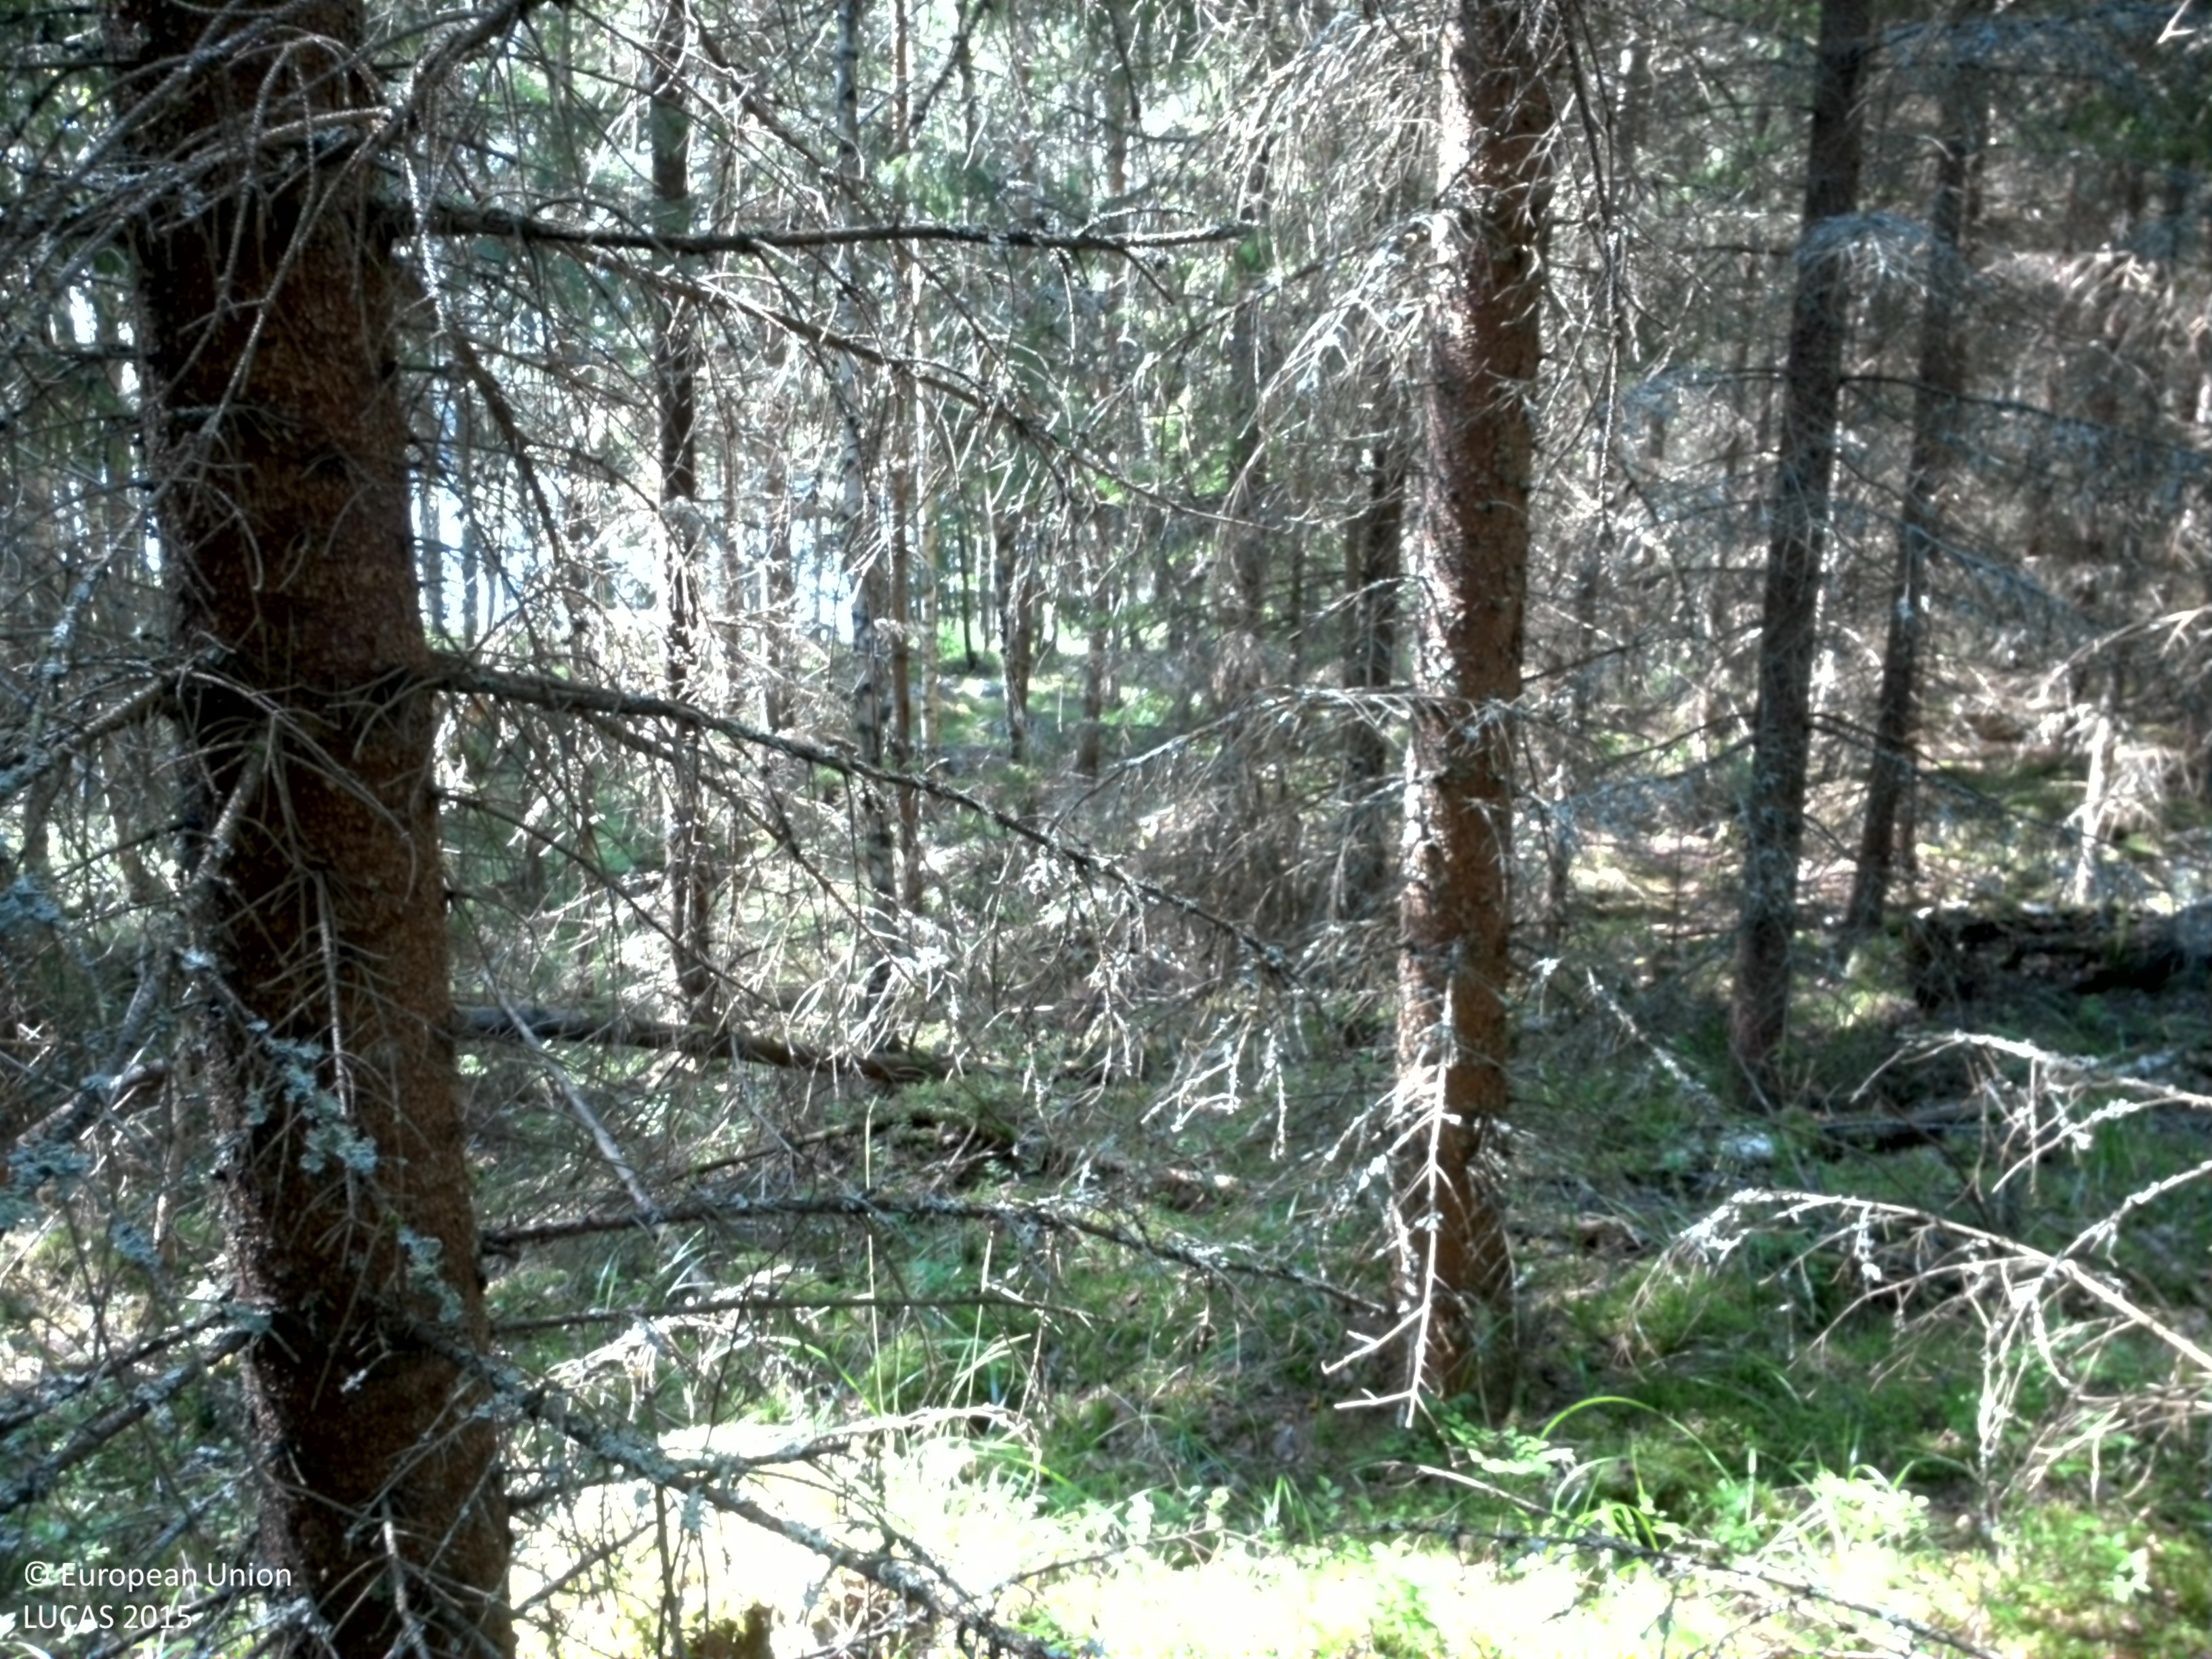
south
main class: Woodland
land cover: Spruce dominated coniferous woodland
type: boreal forest
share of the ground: > 75 %
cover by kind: coniferous forest trees 80 %, lichens and mosses 10 %, broadleaved forest trees 5 %, herbaceous plants 5 %
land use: Forestry
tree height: > 5 m
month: July
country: SE
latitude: 58.7689
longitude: 14.6789
